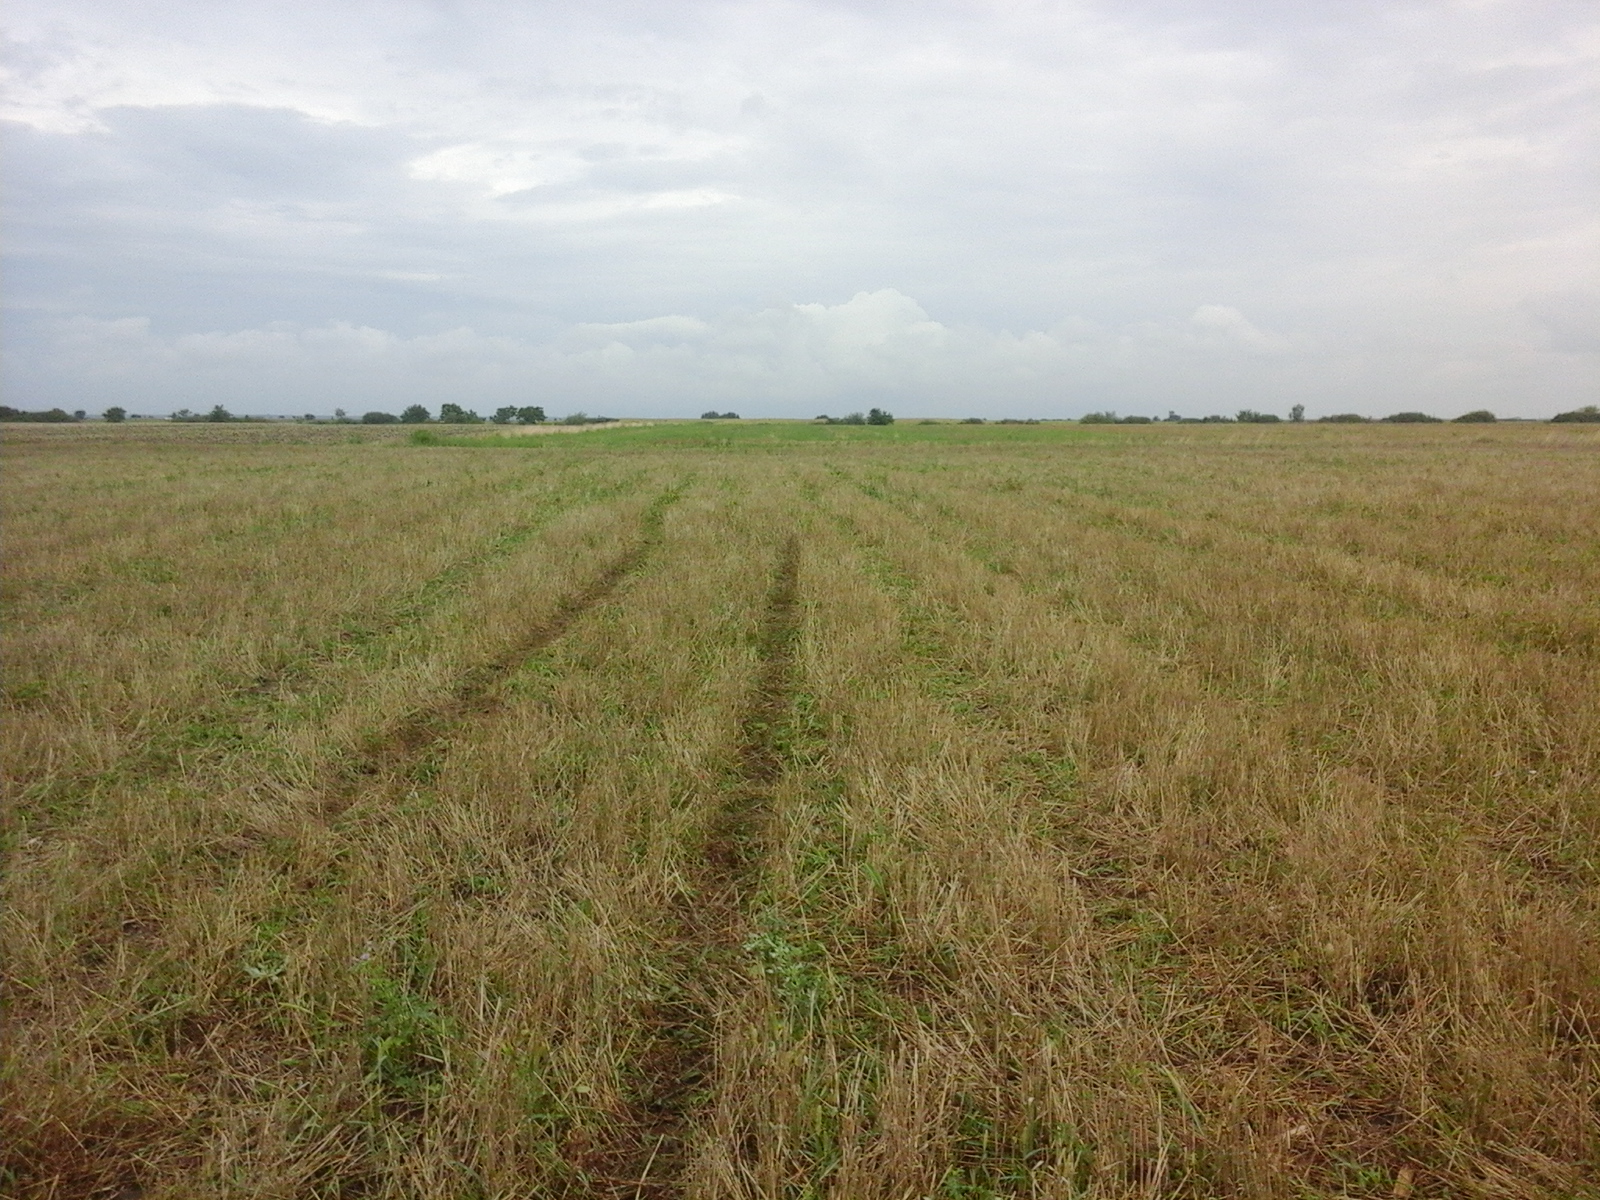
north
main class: Cropland
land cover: Common wheat
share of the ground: 50 - 75 %
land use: Agriculture (excluding fallow land and kitchen gardens)
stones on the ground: < 10 %
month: August
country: RO
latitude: 45.5816
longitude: 21.3476
